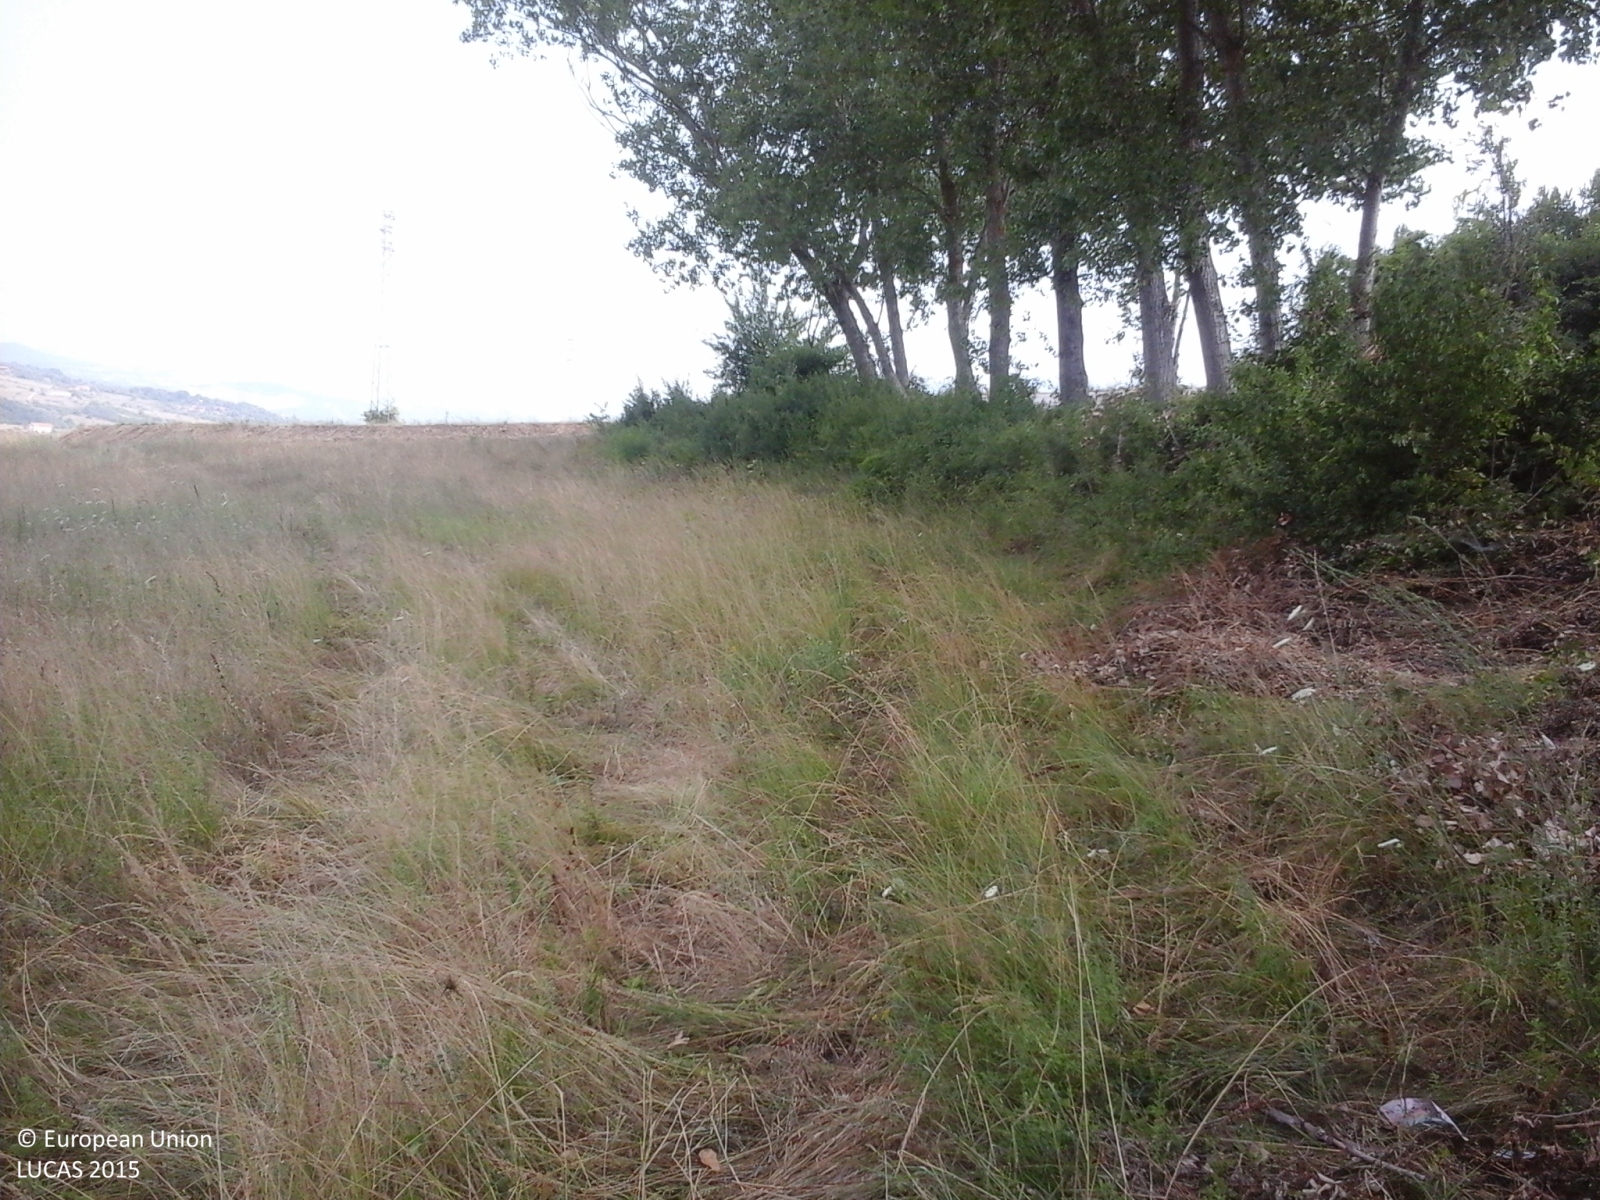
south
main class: Grassland
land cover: Grassland without tree/shrub cover
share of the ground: > 75 %
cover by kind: herbaceous plants 95 %, shrubs 5 %
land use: Abandoned areas
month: July
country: IT
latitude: 40.9118
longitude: 15.1448
